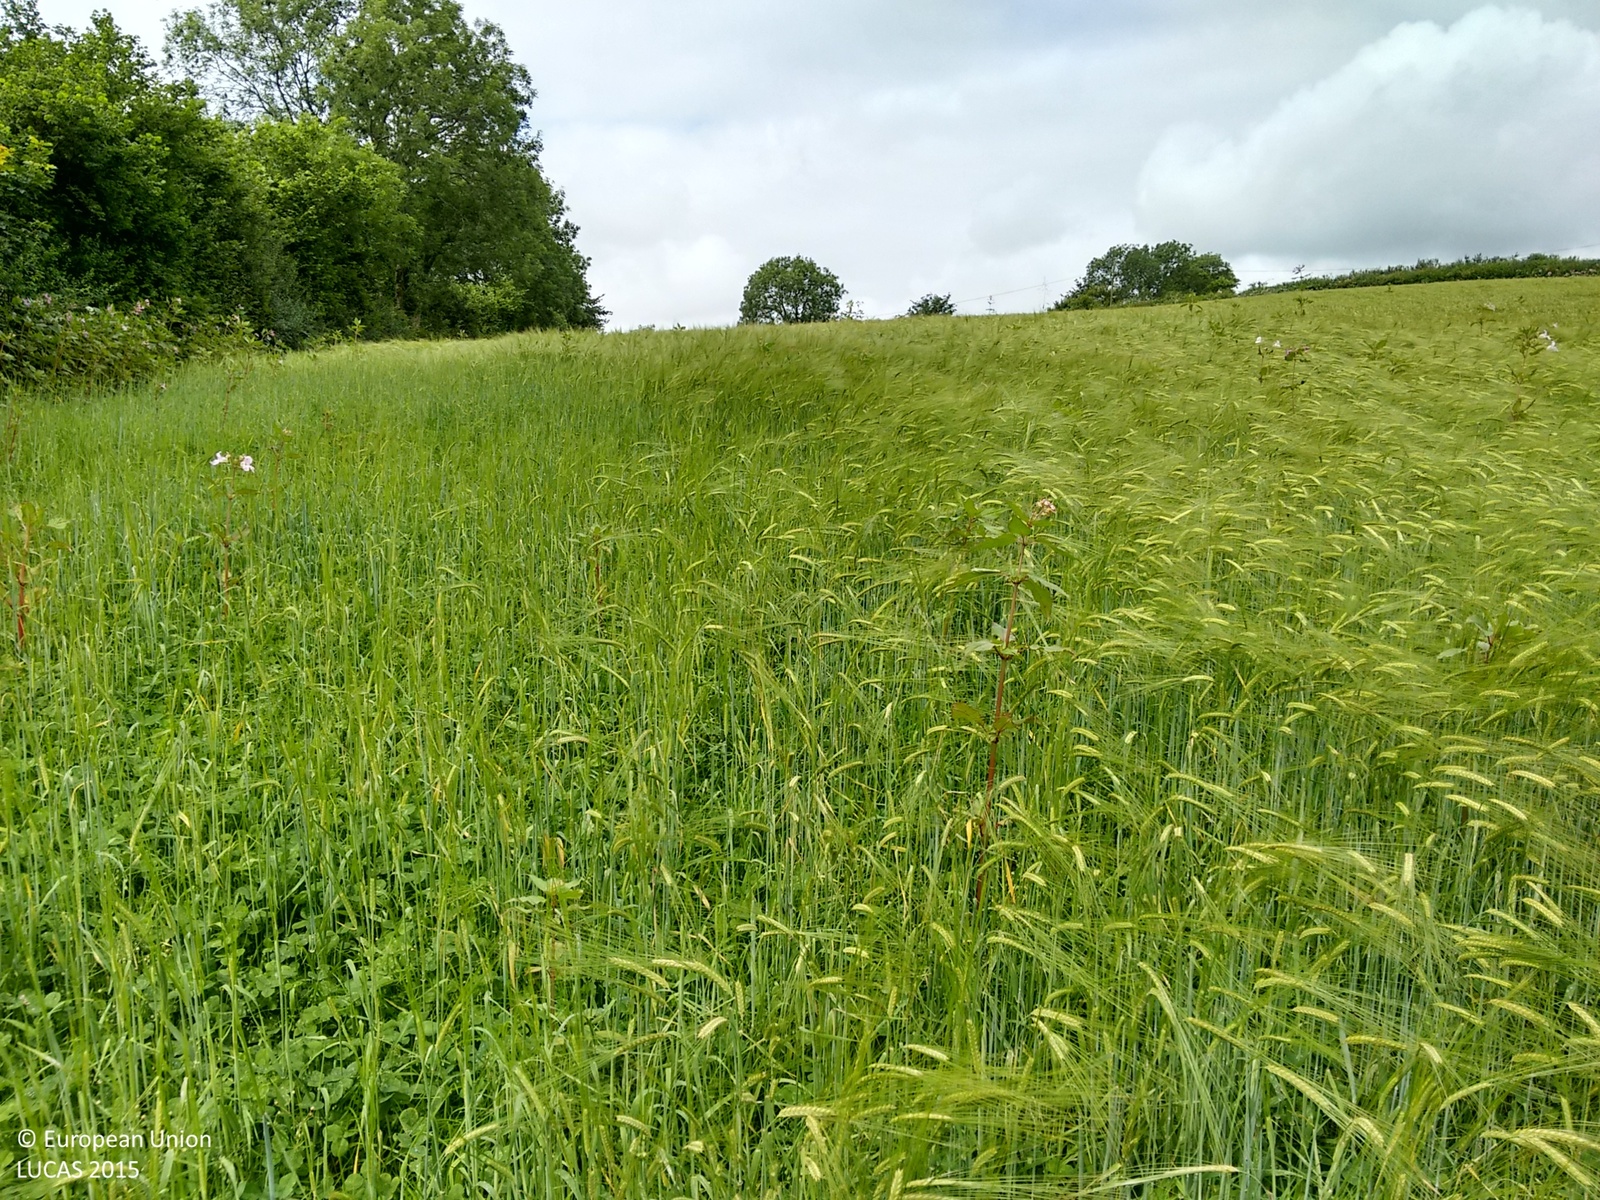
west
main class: Cropland
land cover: Barley
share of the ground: > 75 %
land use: Agriculture (excluding fallow land and kitchen gardens)
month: July
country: GB
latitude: 51.5501
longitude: -3.6286
